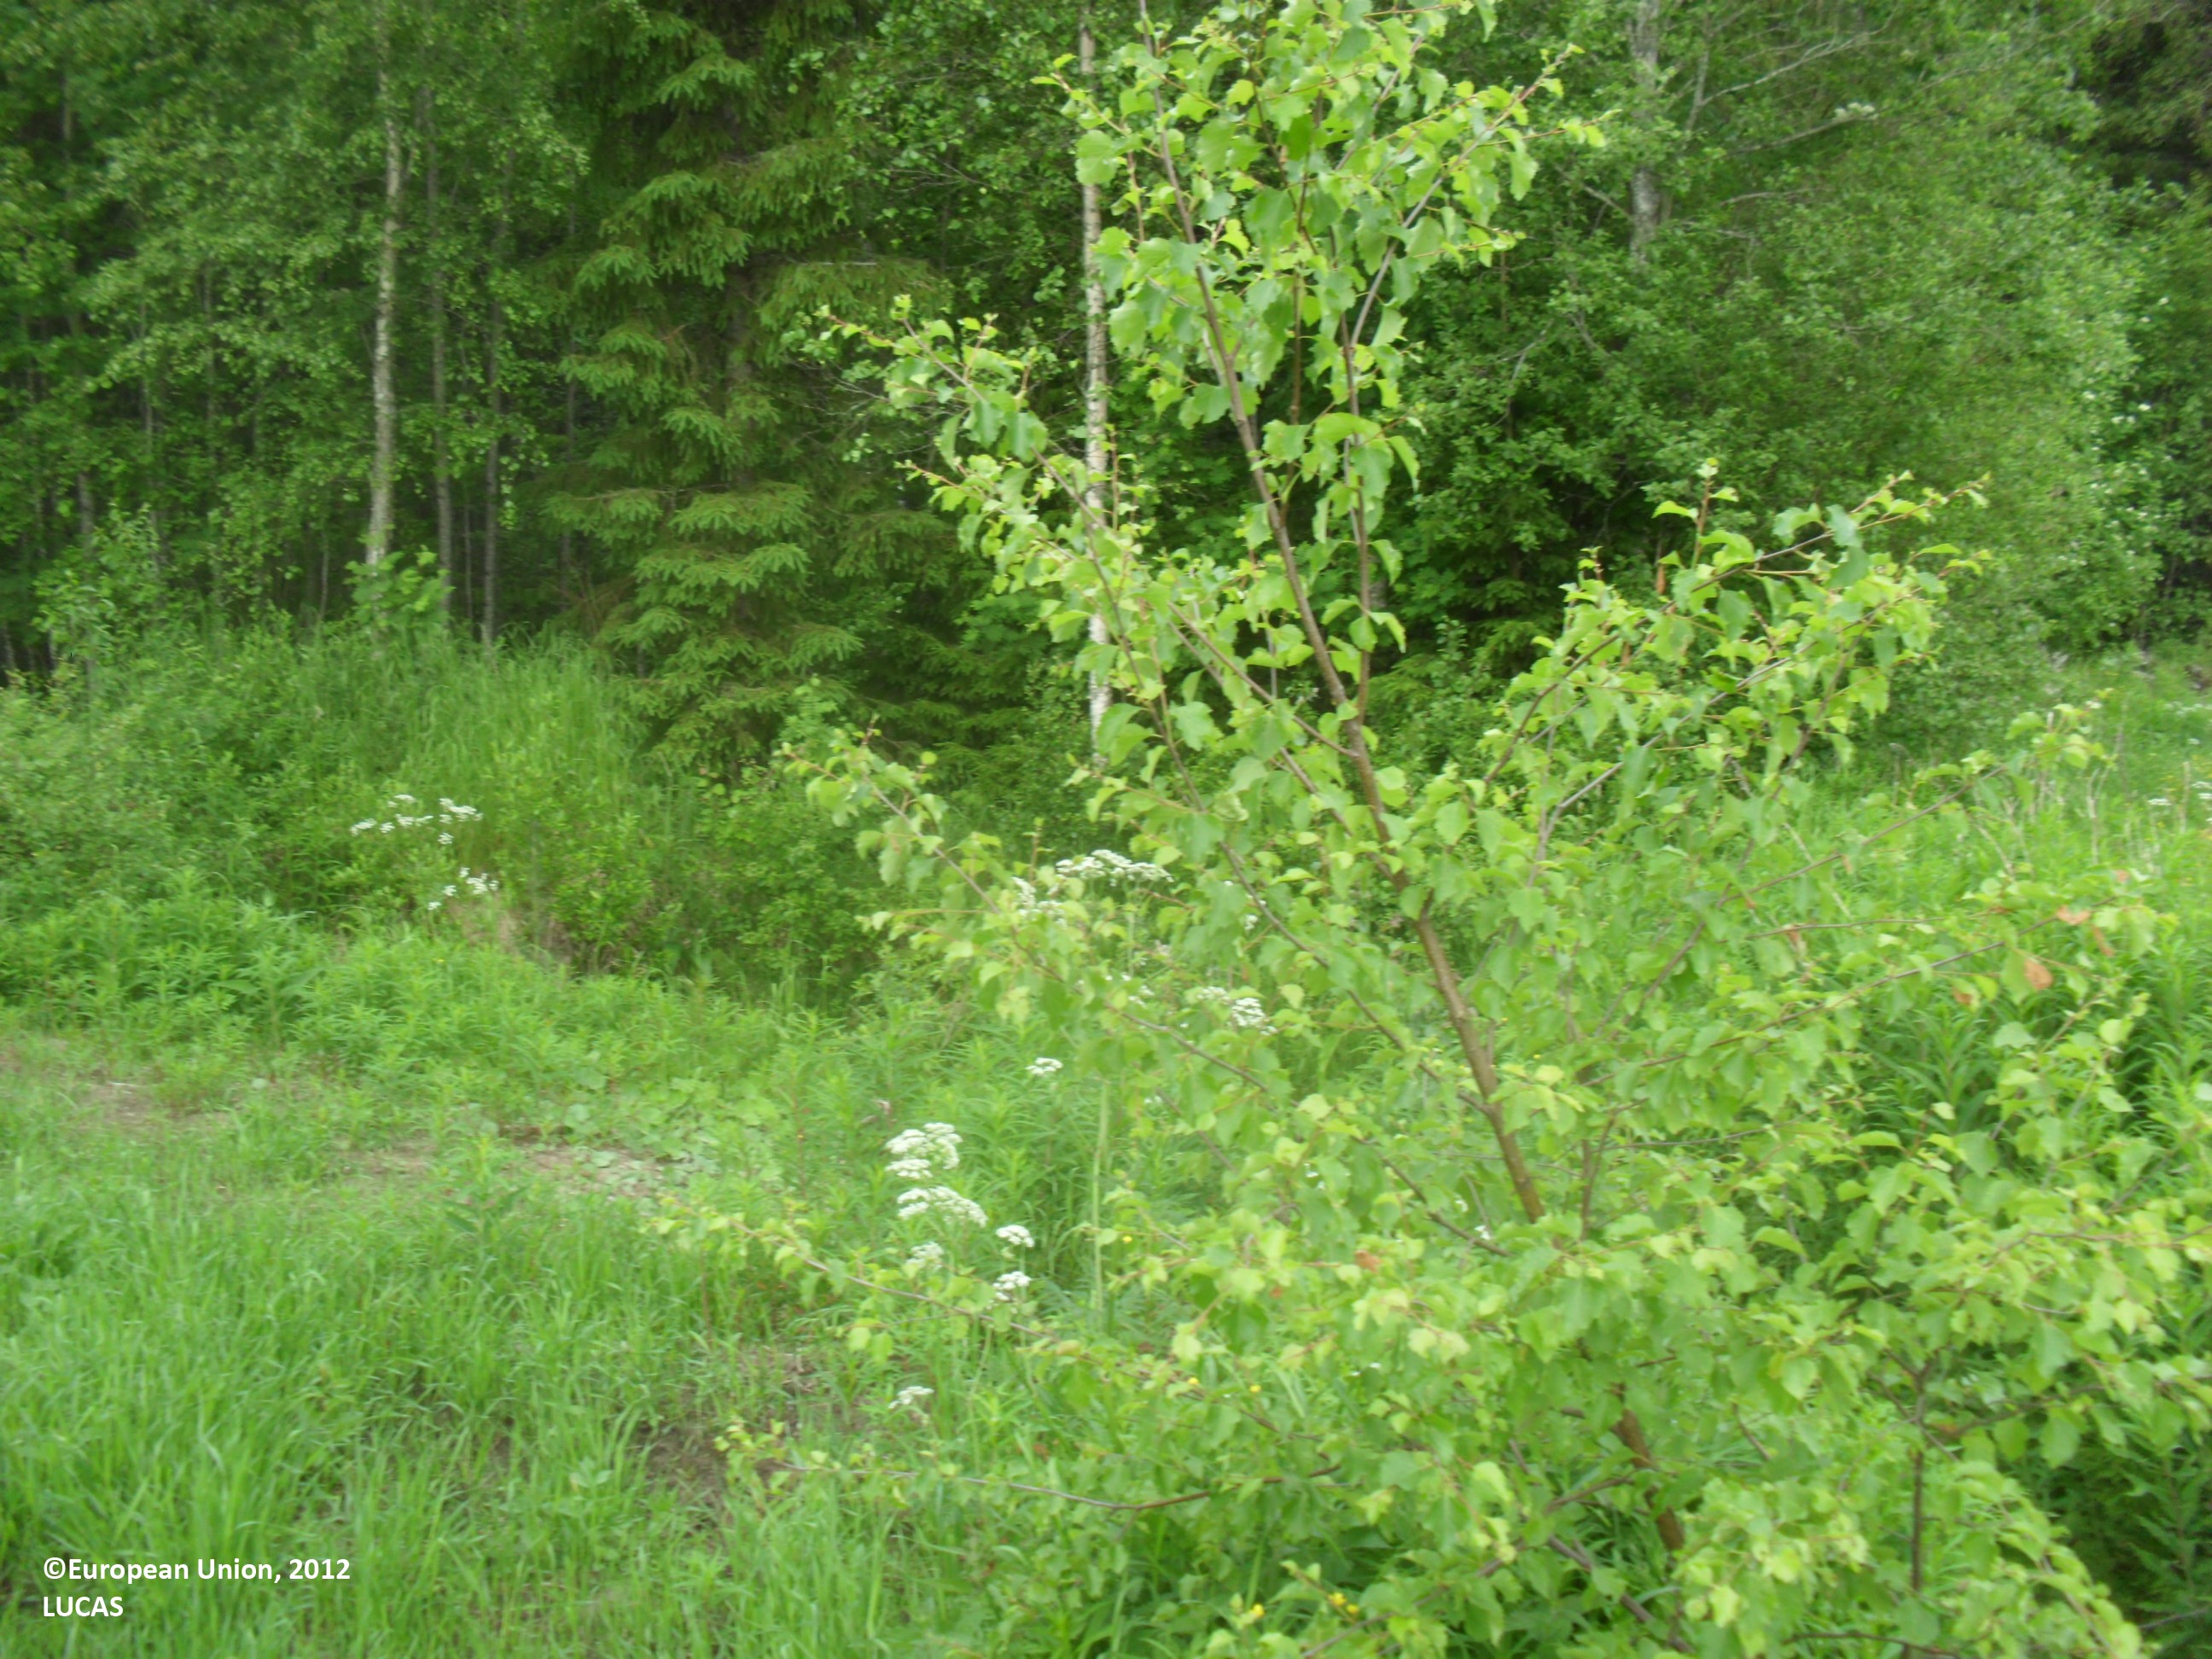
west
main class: Cropland
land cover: Barley
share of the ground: 25 - 50 %
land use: Agriculture (excluding fallow land and kitchen gardens)
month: June
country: FI
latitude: 63.3535
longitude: 23.3514
